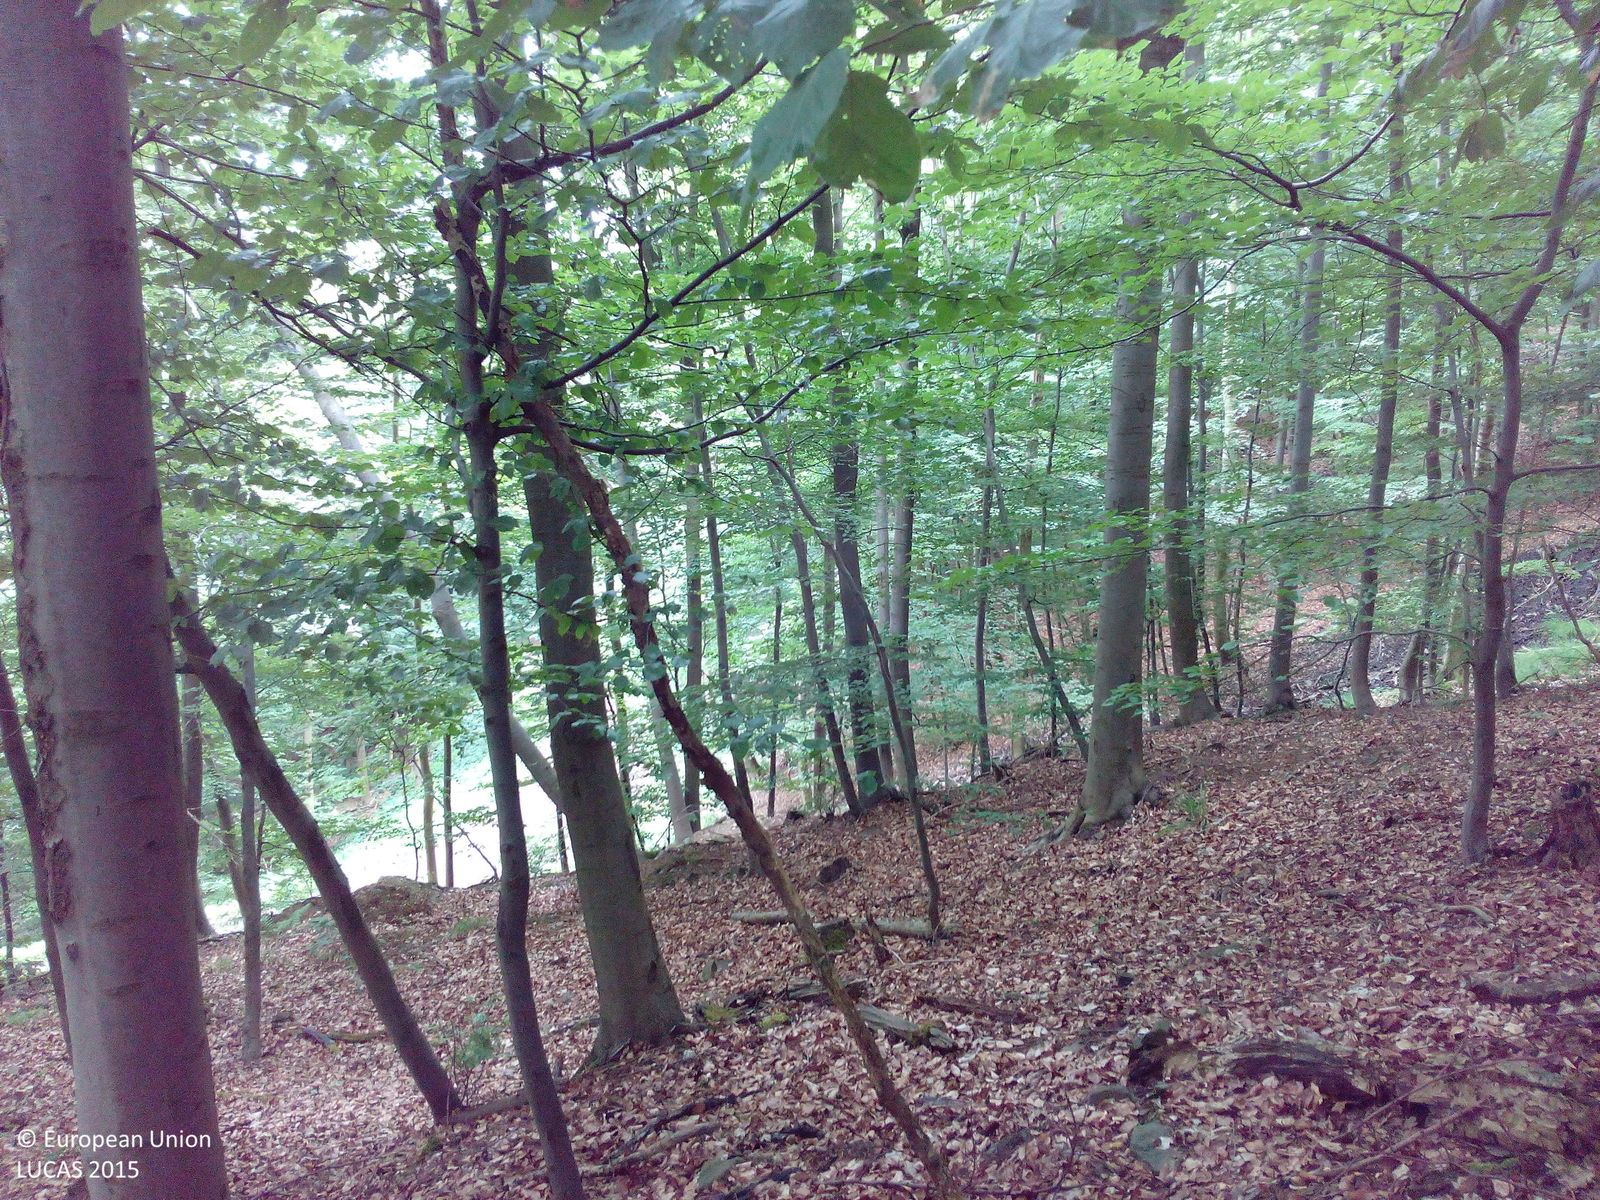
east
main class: Woodland
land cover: Broadleaved woodland
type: beech forest
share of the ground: > 75 %
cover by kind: broadleaved forest trees 95 %, unconsolidated bare surface 5 %
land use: Forestry
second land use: Amenities, museums, leisure
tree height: > 5 m
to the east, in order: Broadleaved woodland; Tracks; Broadleaved woodland
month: May
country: DE
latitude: 51.9457
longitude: 10.2763
